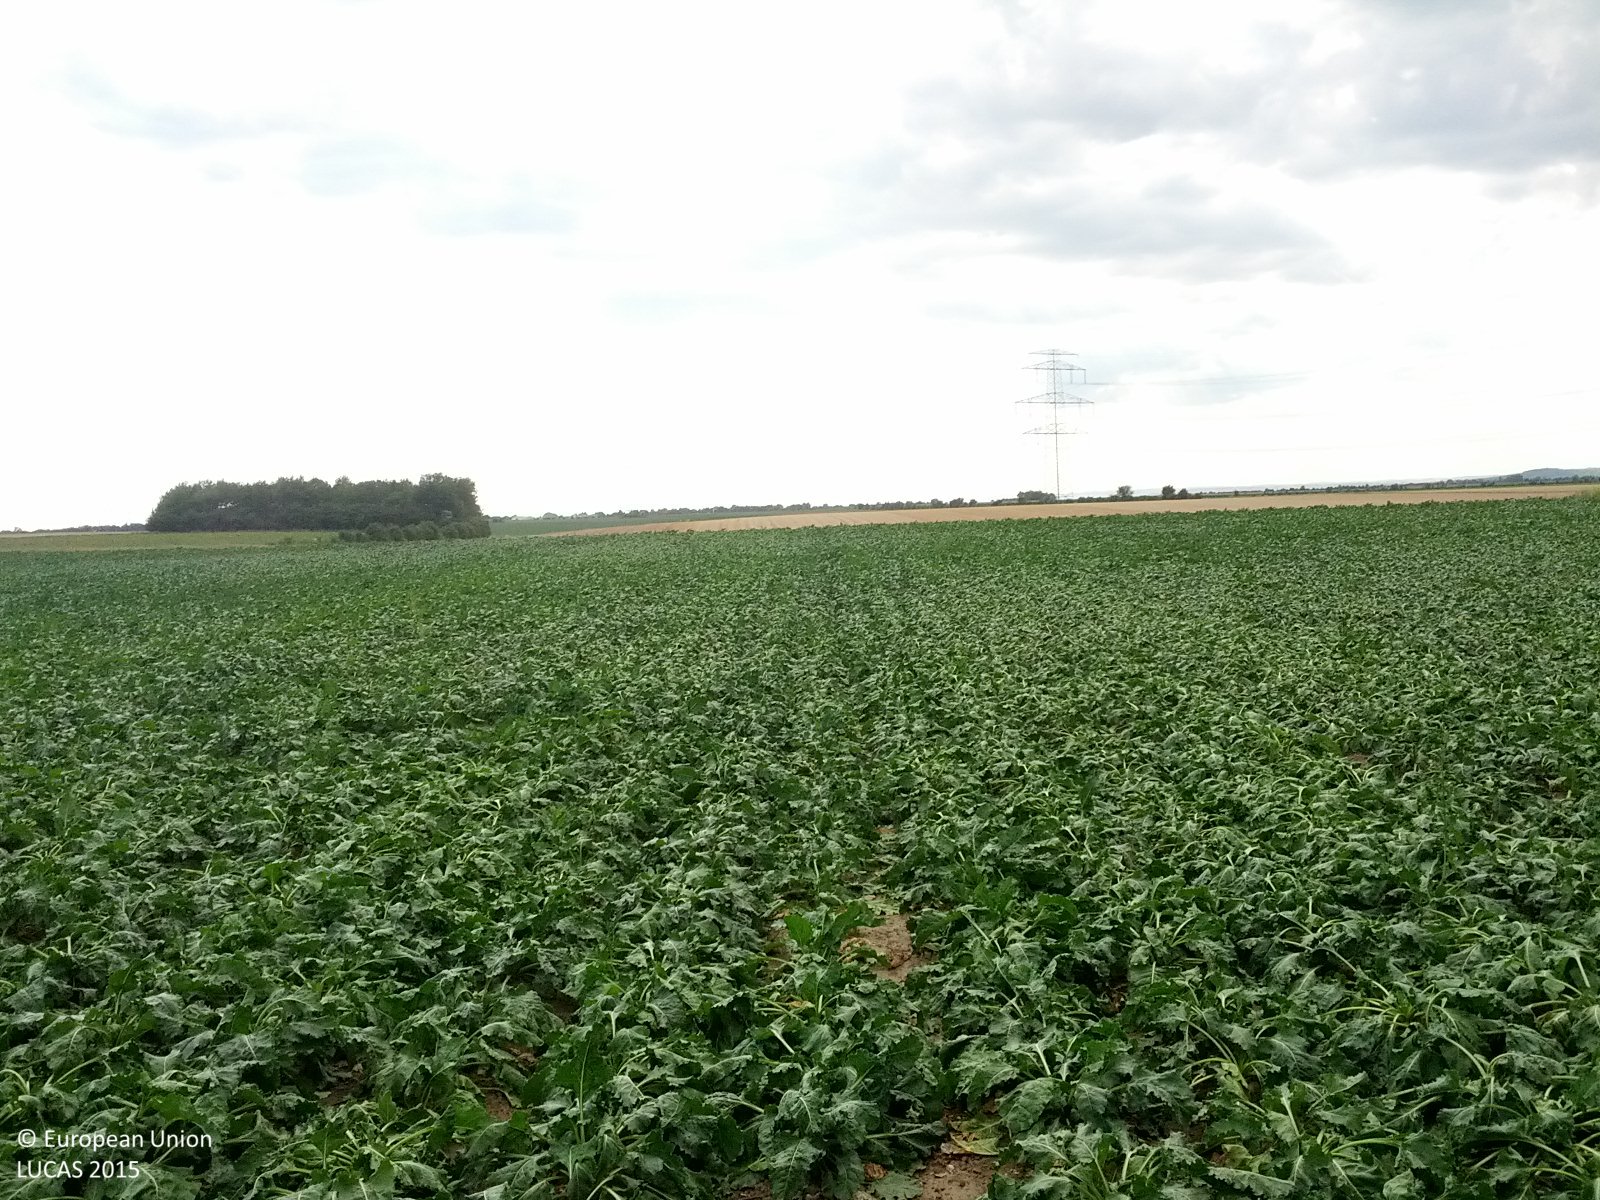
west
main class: Cropland
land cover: Sugar beet
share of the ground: > 75 %
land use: Agriculture (excluding fallow land and kitchen gardens)
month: July
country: AT
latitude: 48.4141
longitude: 16.1249
